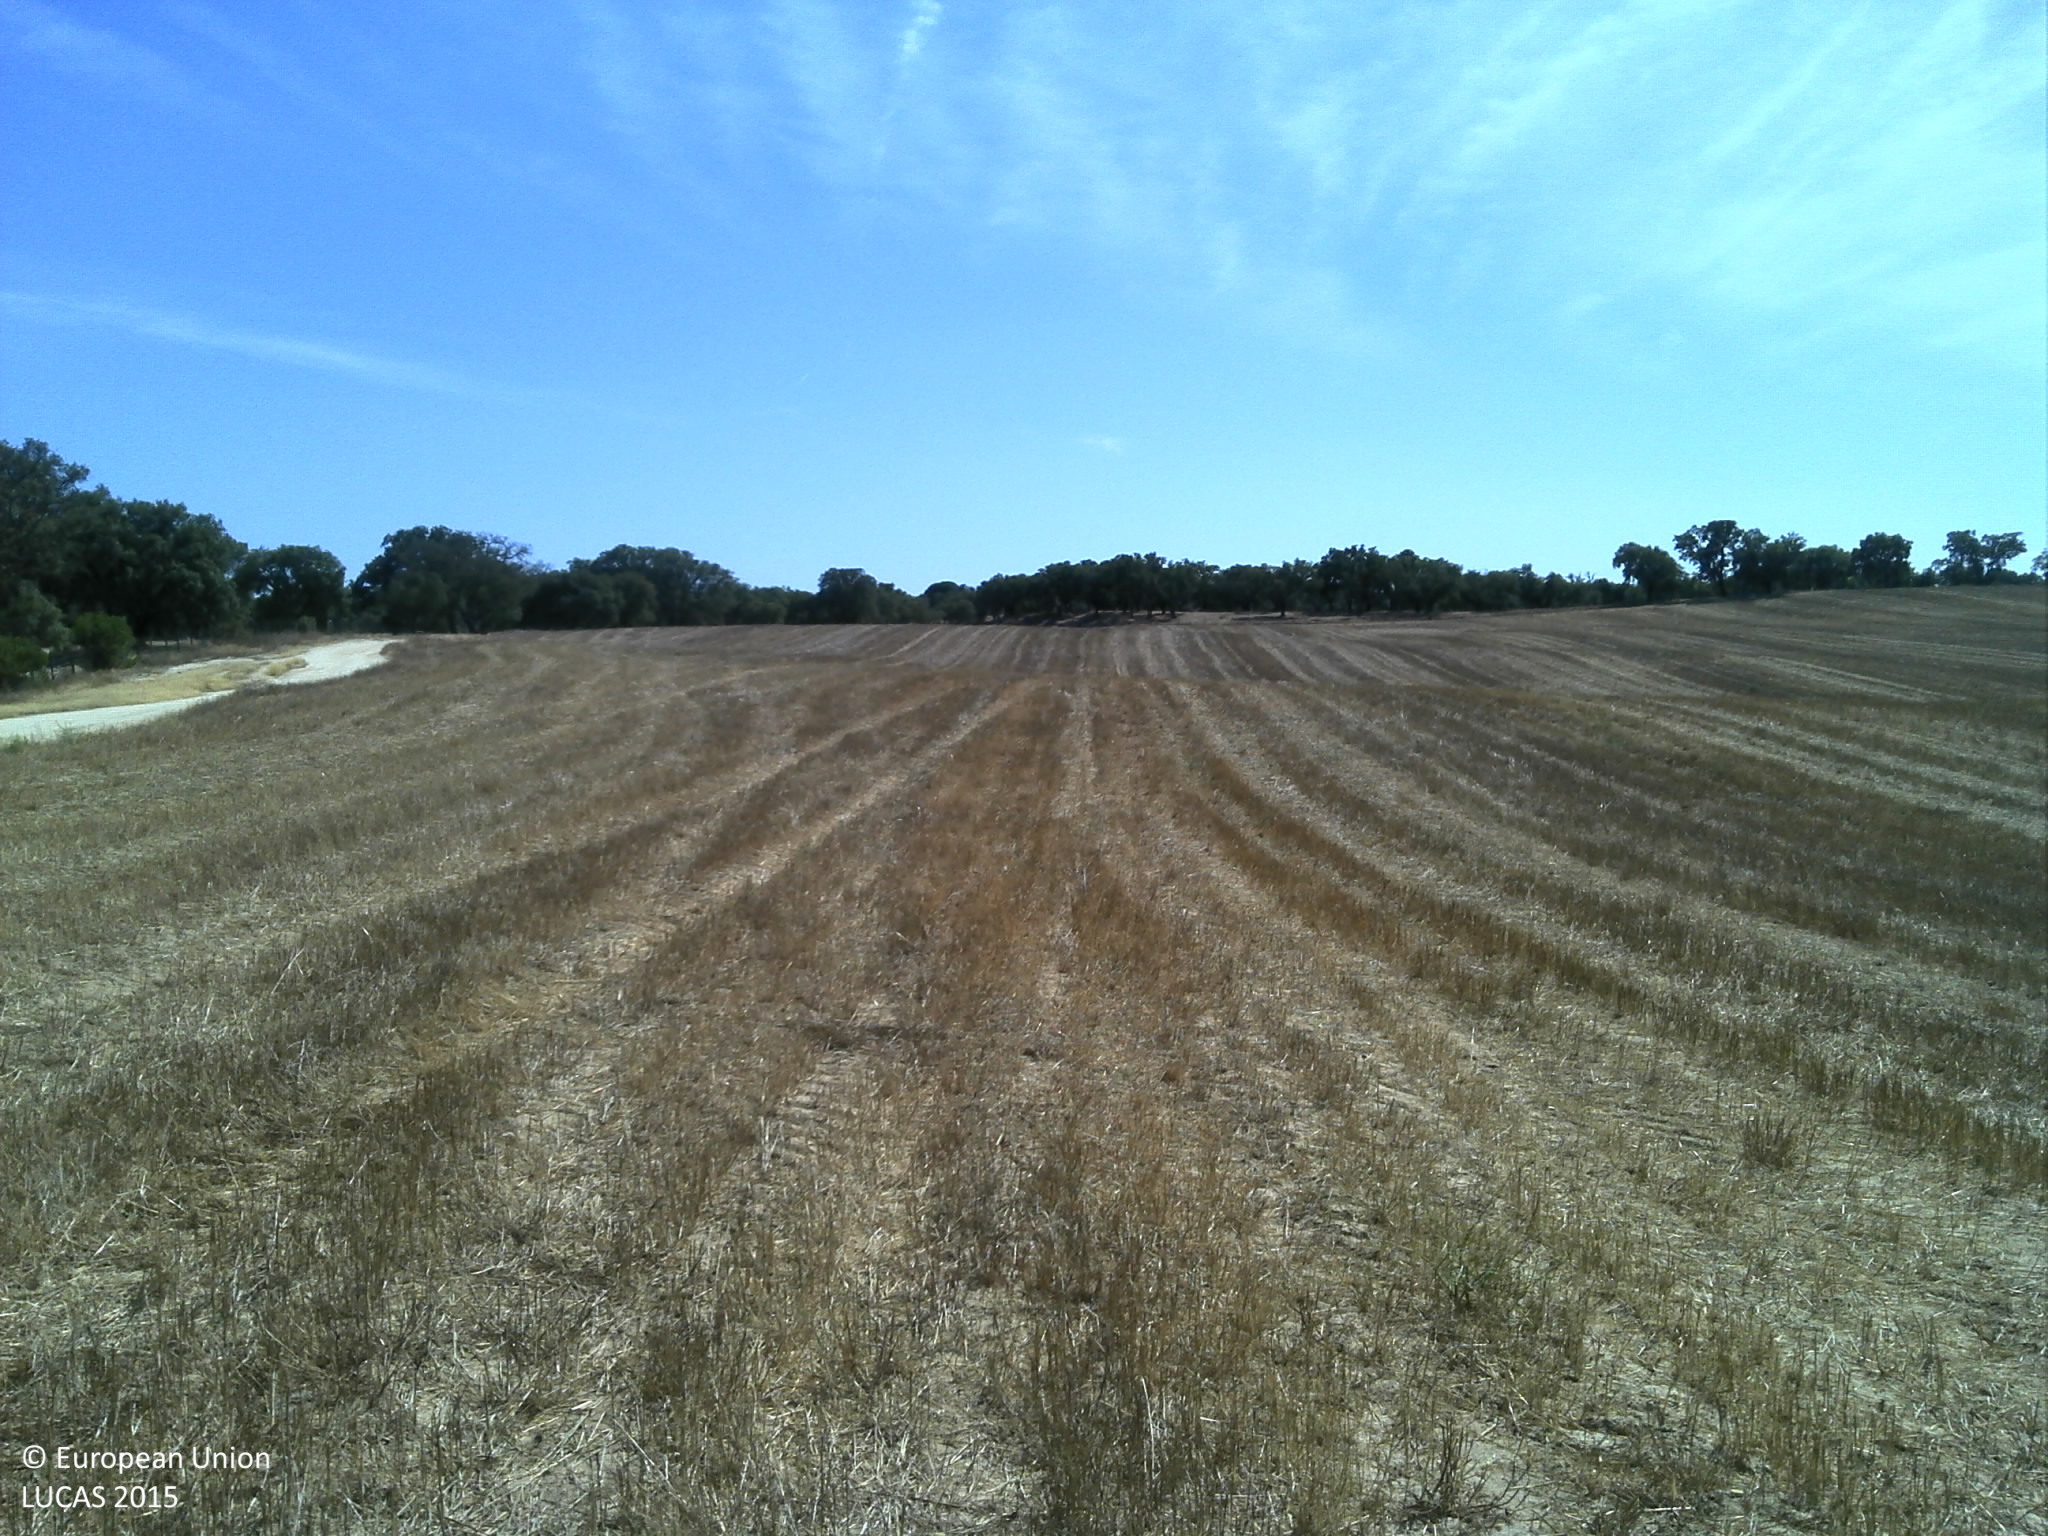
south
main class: Cropland
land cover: Common wheat
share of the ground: < 10 %
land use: Agriculture (excluding fallow land and kitchen gardens)
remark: Harvested field
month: August
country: PT
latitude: 38.7229
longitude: -8.5422
